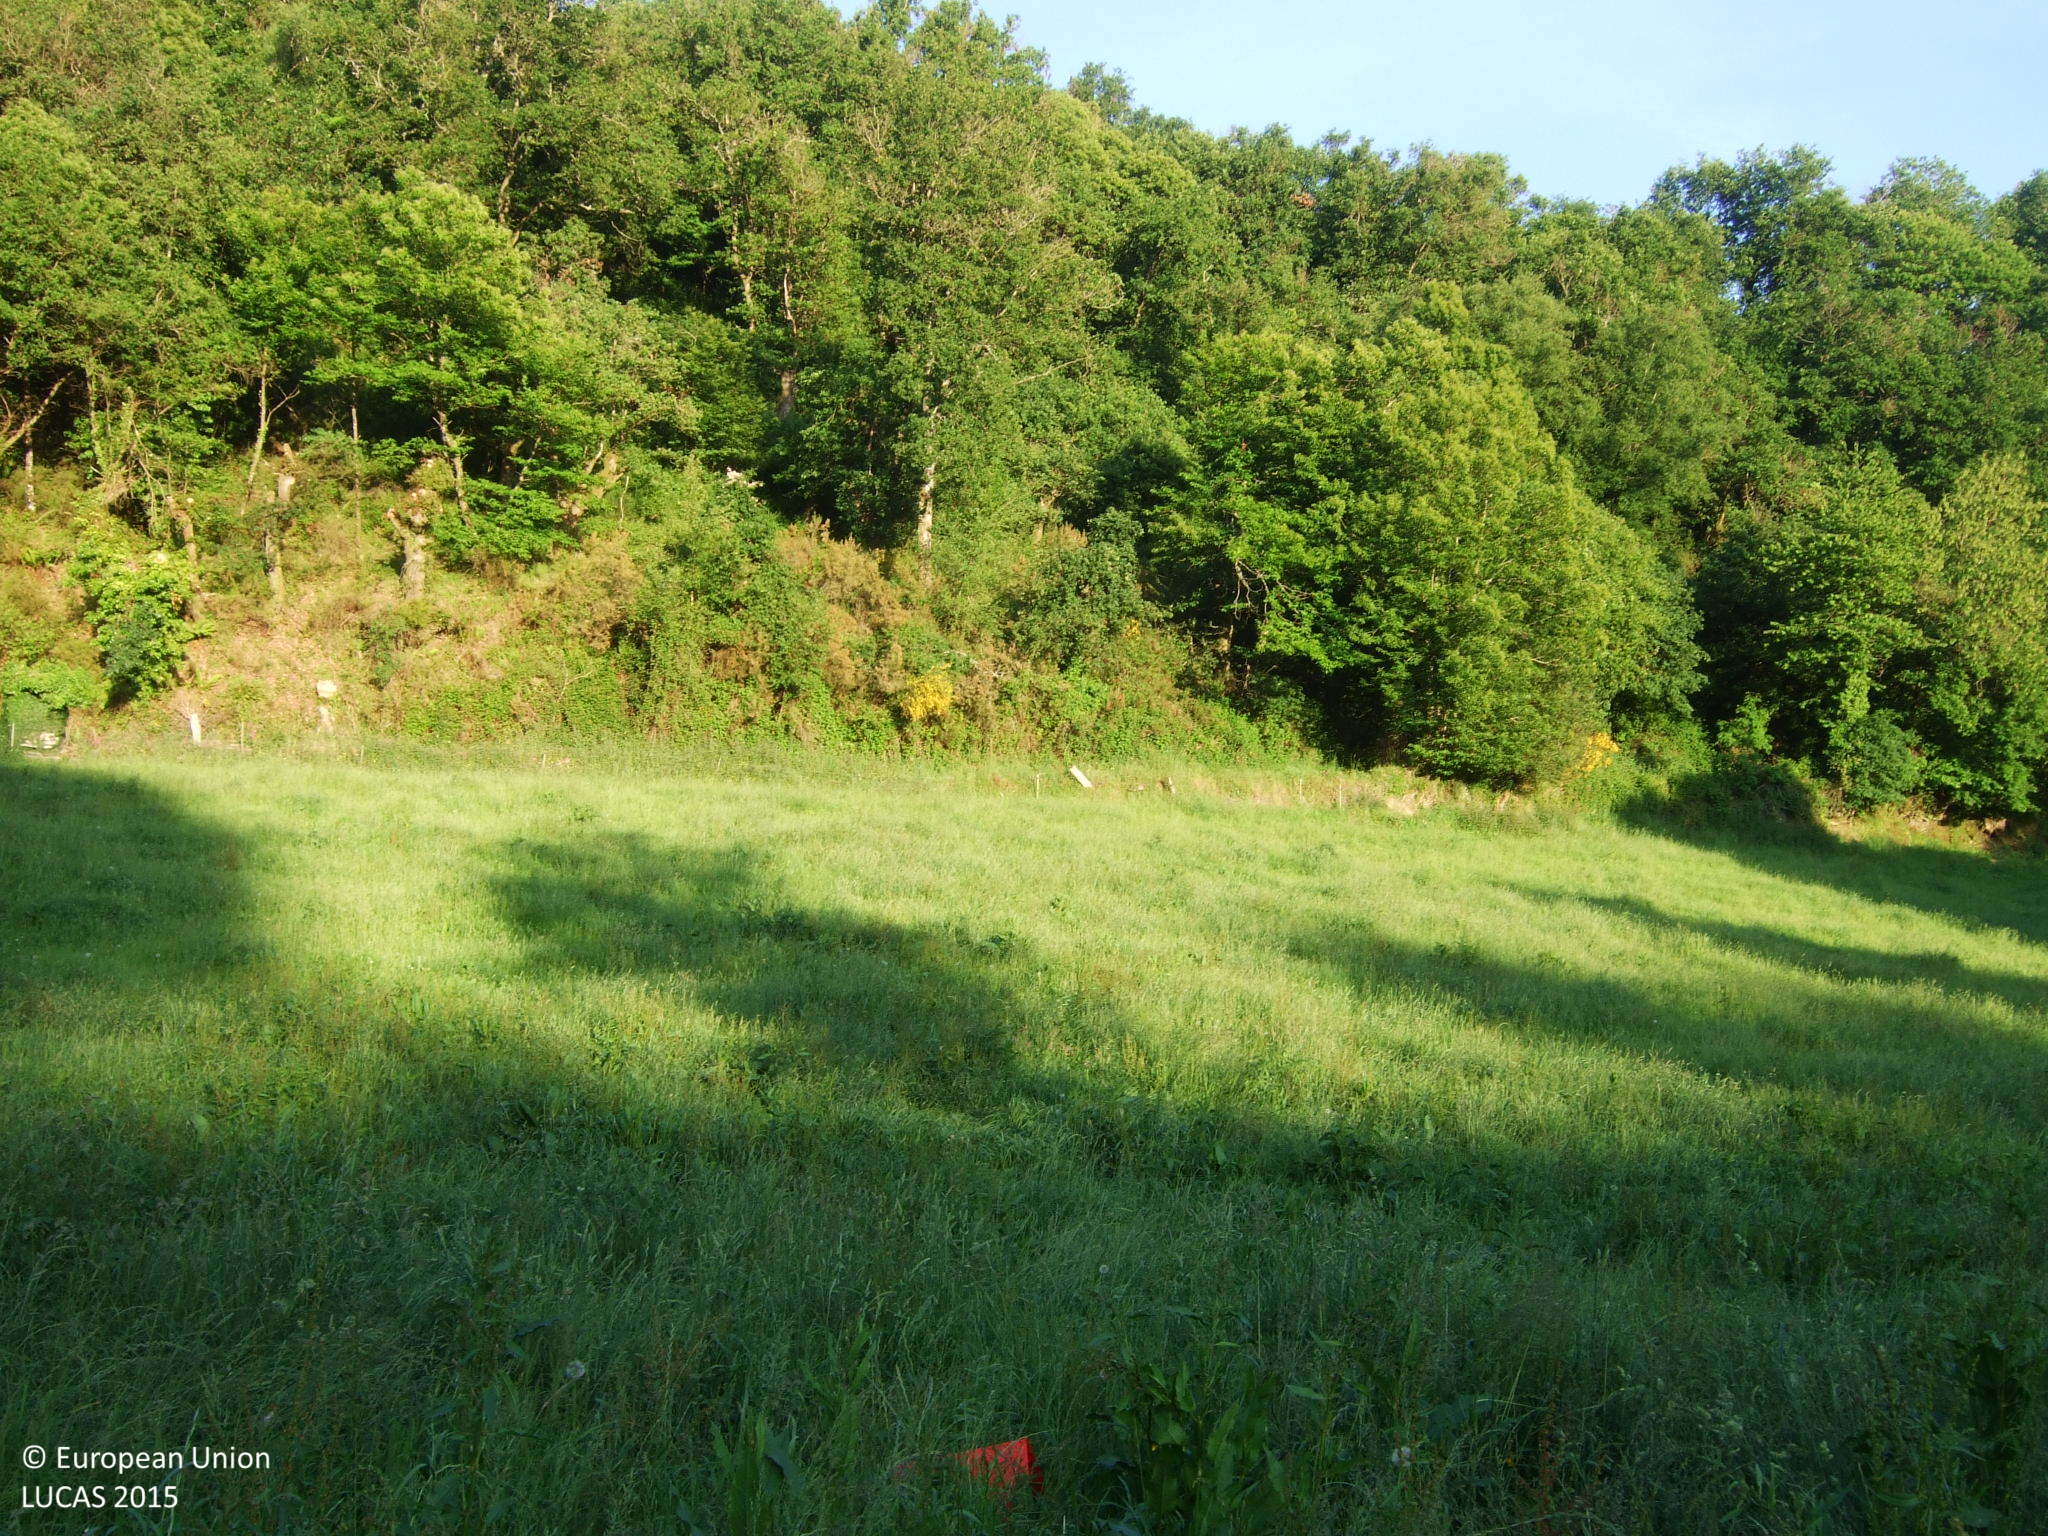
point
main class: Grassland
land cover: Grassland without tree/shrub cover
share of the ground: > 75 %
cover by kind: herbaceous plants 100 %
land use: Agriculture (excluding fallow land and kitchen gardens)
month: June
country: ES
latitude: 42.7713
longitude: -7.3121
